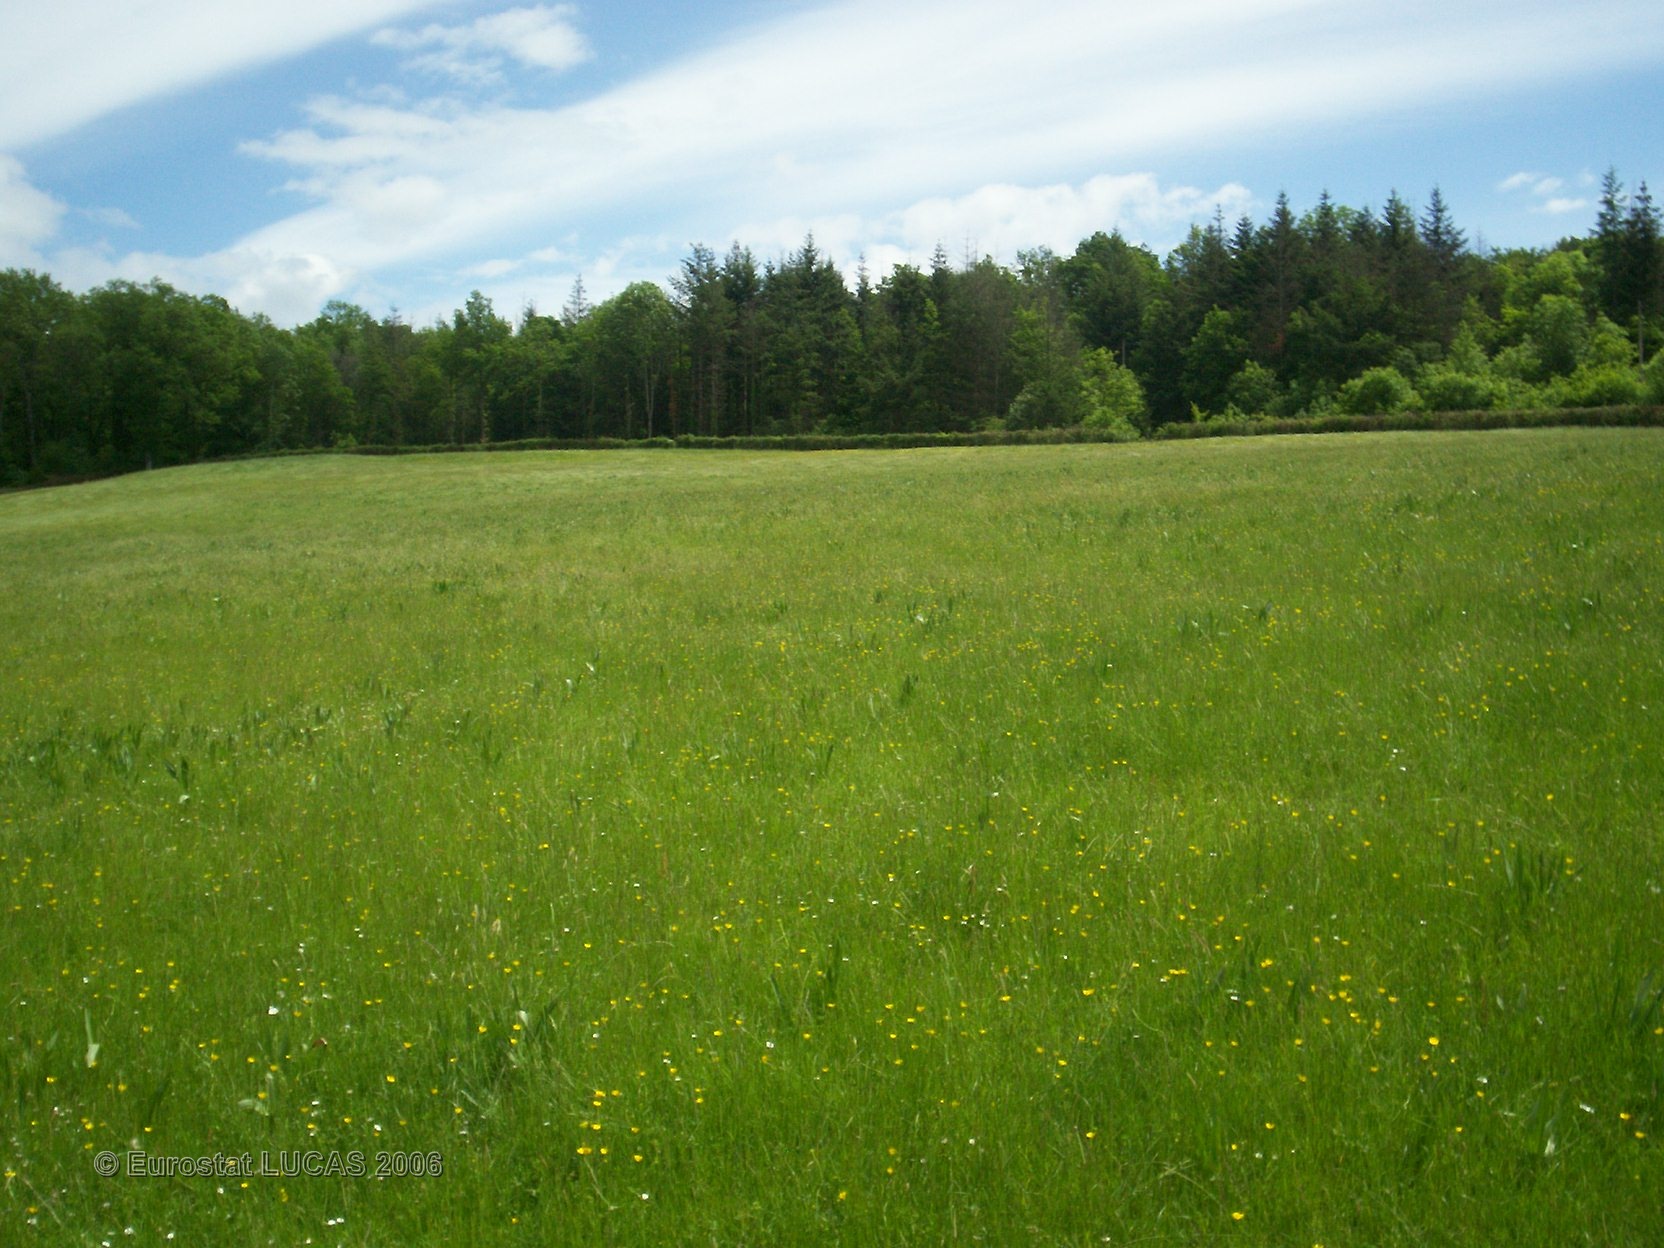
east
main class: Grassland
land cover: Grassland without tree/shrub cover
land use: Agriculture (excluding fallow land and kitchen gardens)
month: May
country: FR
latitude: 47.0445
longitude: 4.5907
